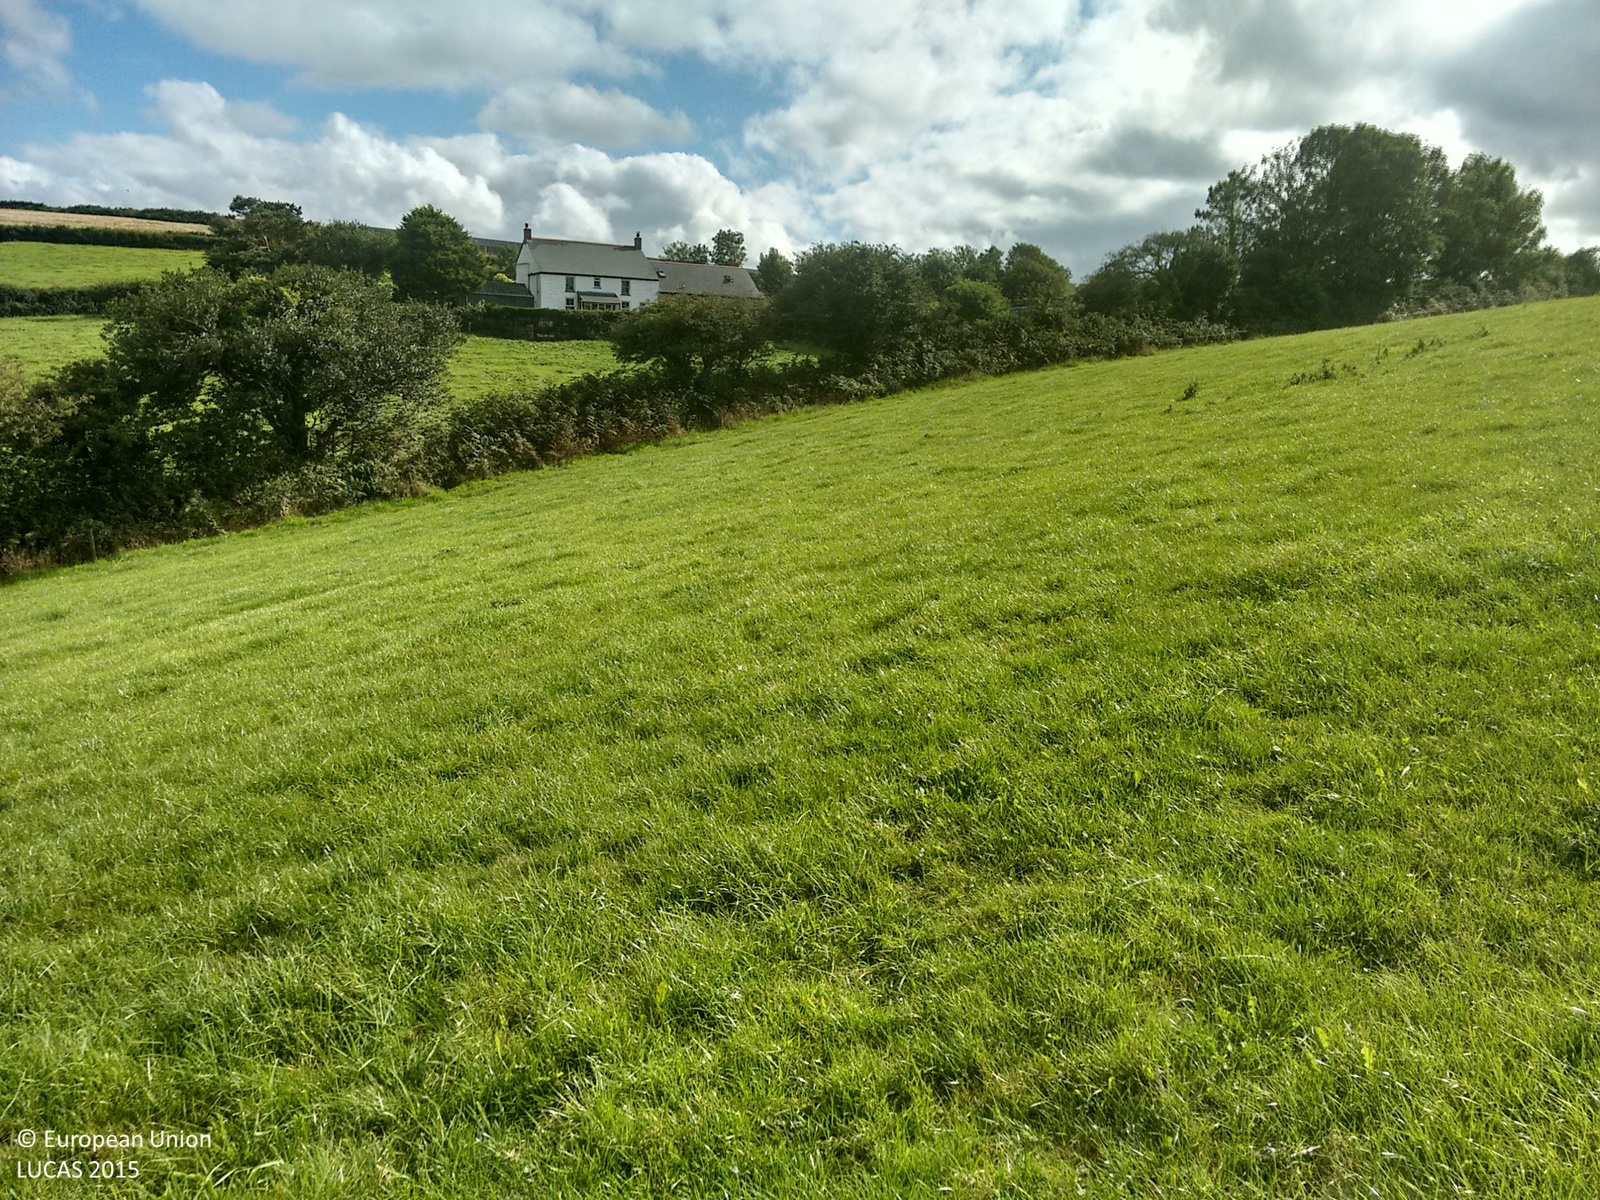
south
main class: Grassland
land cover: Grassland without tree/shrub cover
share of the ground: > 75 %
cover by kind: herbaceous plants 100 %
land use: Agriculture (excluding fallow land and kitchen gardens)
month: September
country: GB
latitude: 50.2031
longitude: -5.1810
